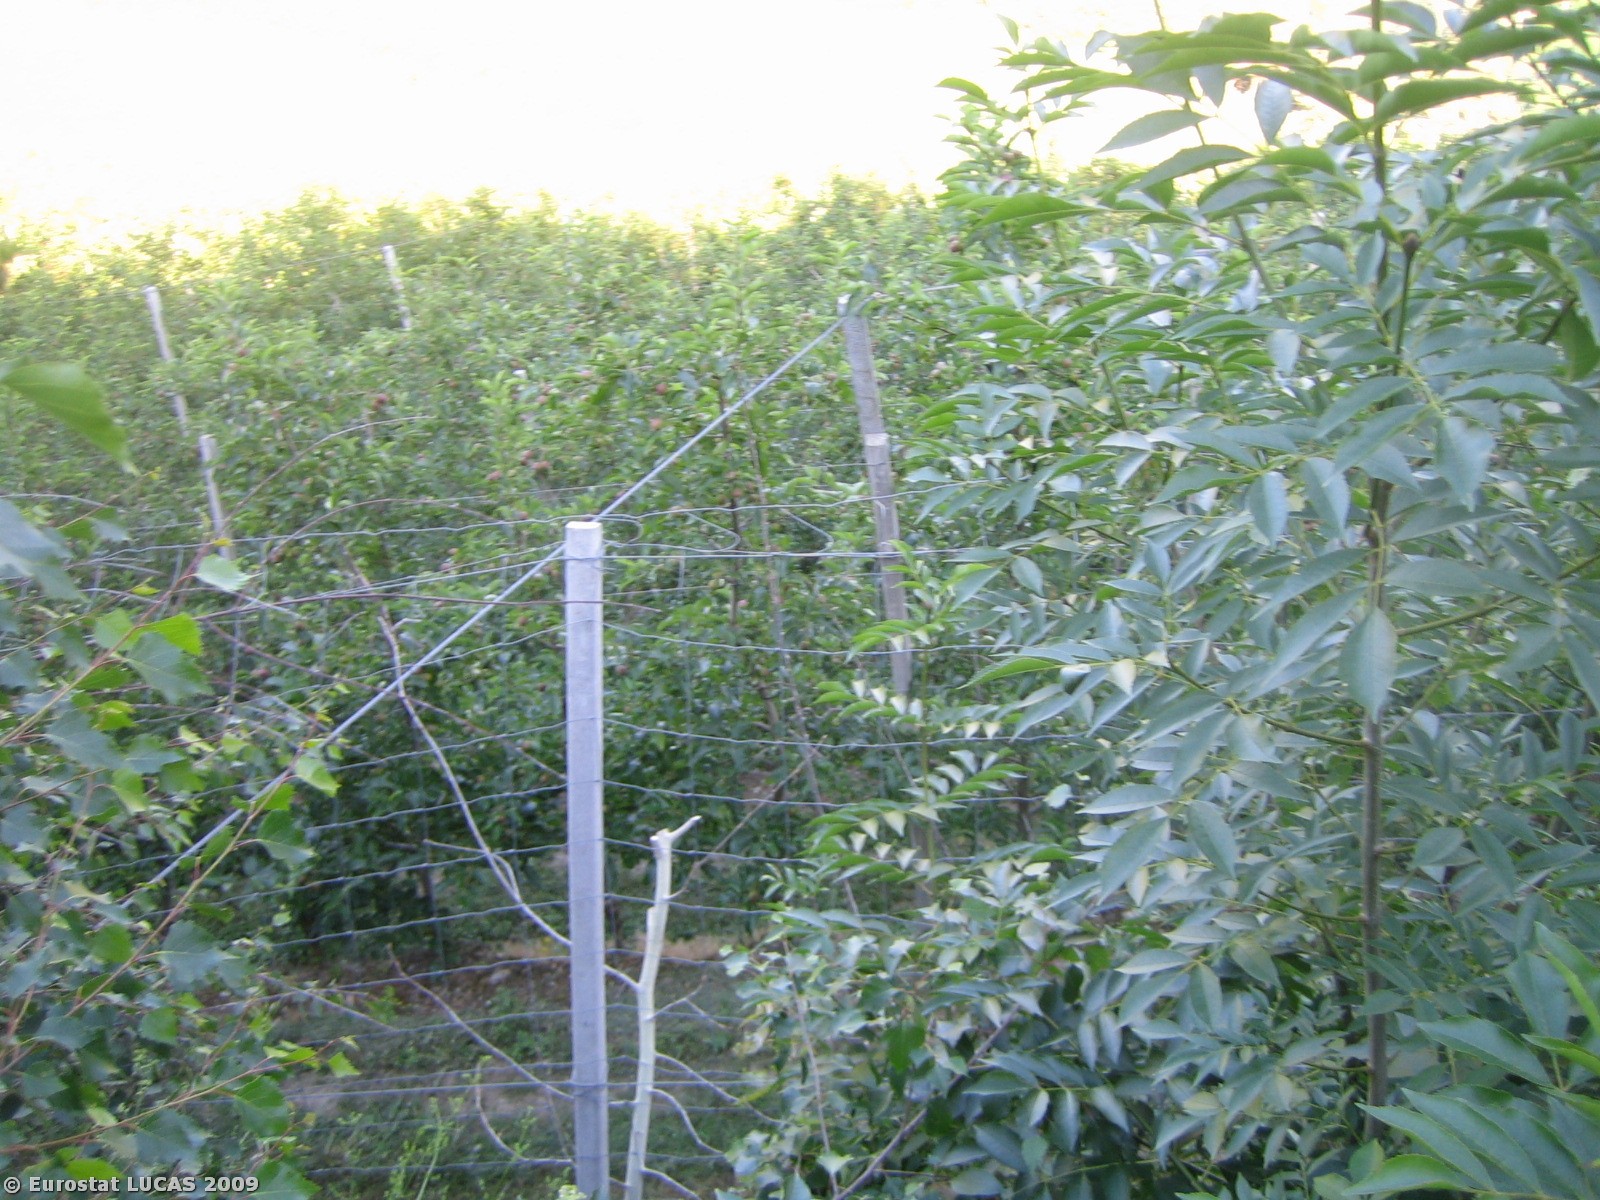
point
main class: Cropland
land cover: Apple fruit
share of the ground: 50 - 75 %
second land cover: Grassland with sparse tree/shrub cover
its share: > 75 %
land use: Agriculture (excluding fallow land and kitchen gardens)
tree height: < 5 m
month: June
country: IT
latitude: 46.7522
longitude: 11.6869
